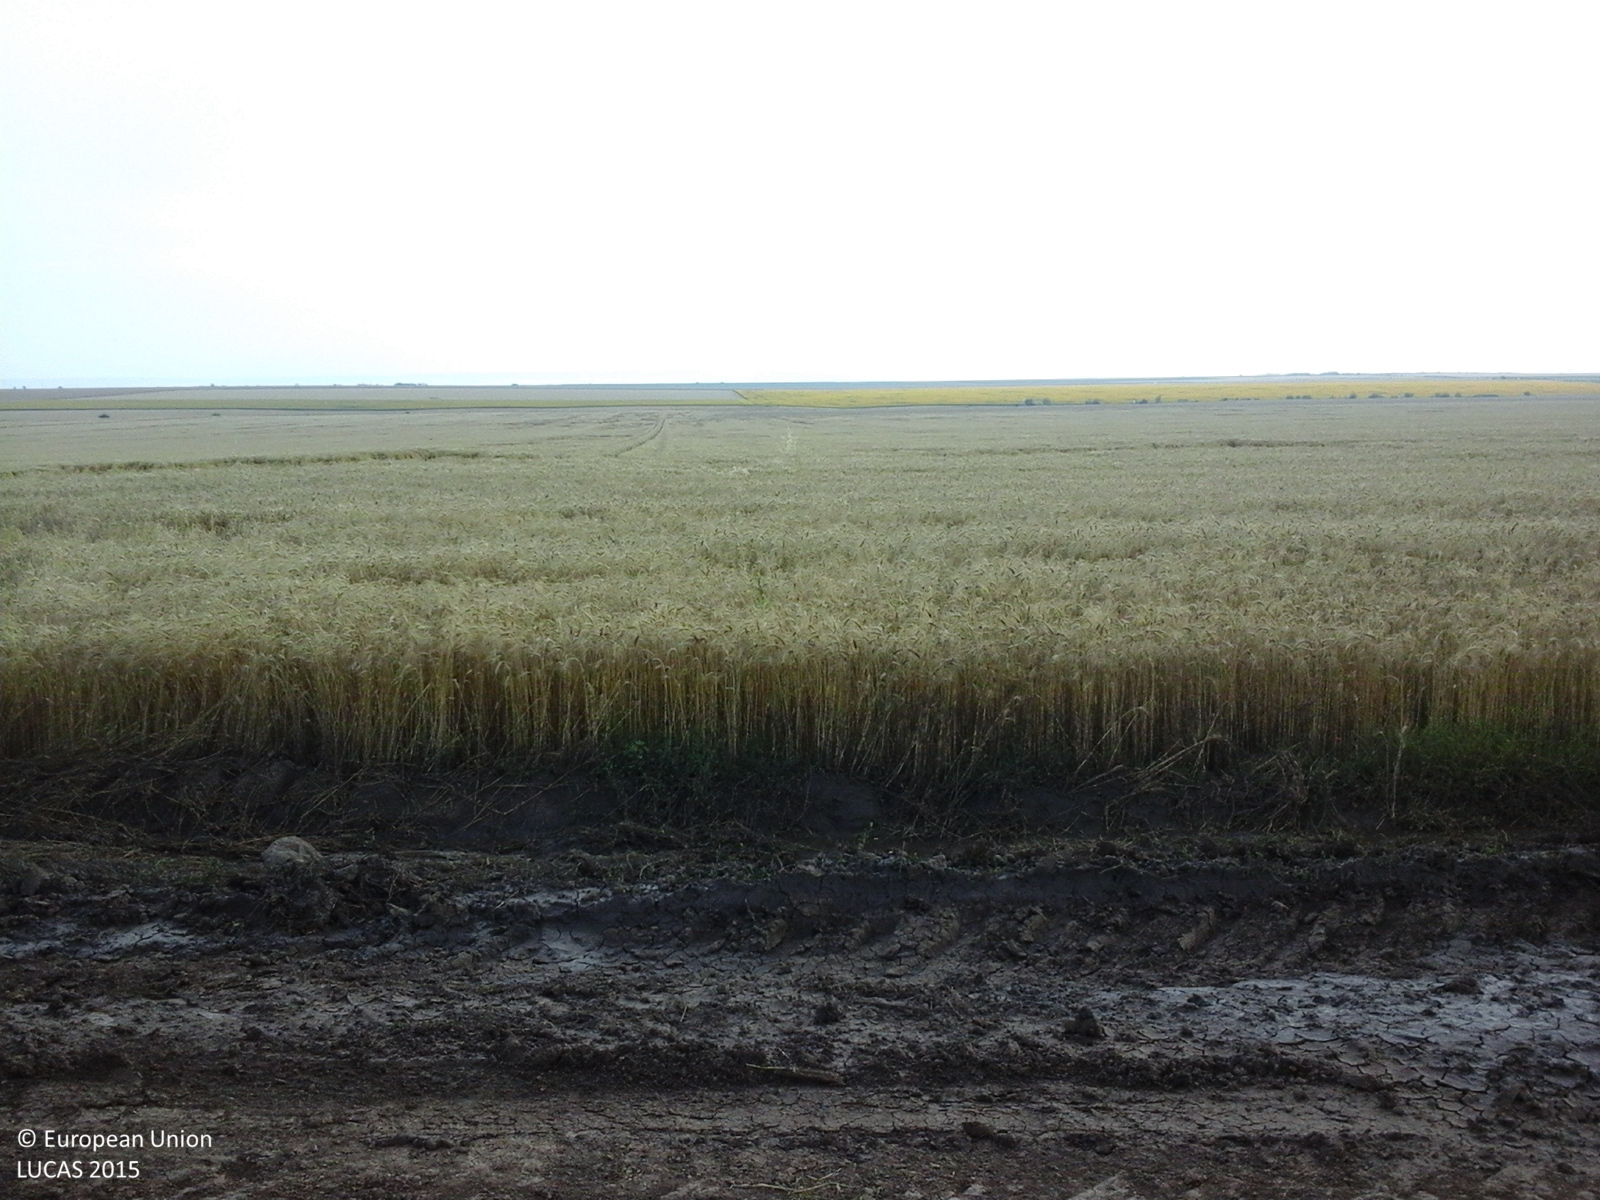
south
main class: Cropland
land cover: Common wheat
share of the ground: > 75 %
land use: Agriculture (excluding fallow land and kitchen gardens)
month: July
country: RO
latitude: 43.7652
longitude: 25.3731
